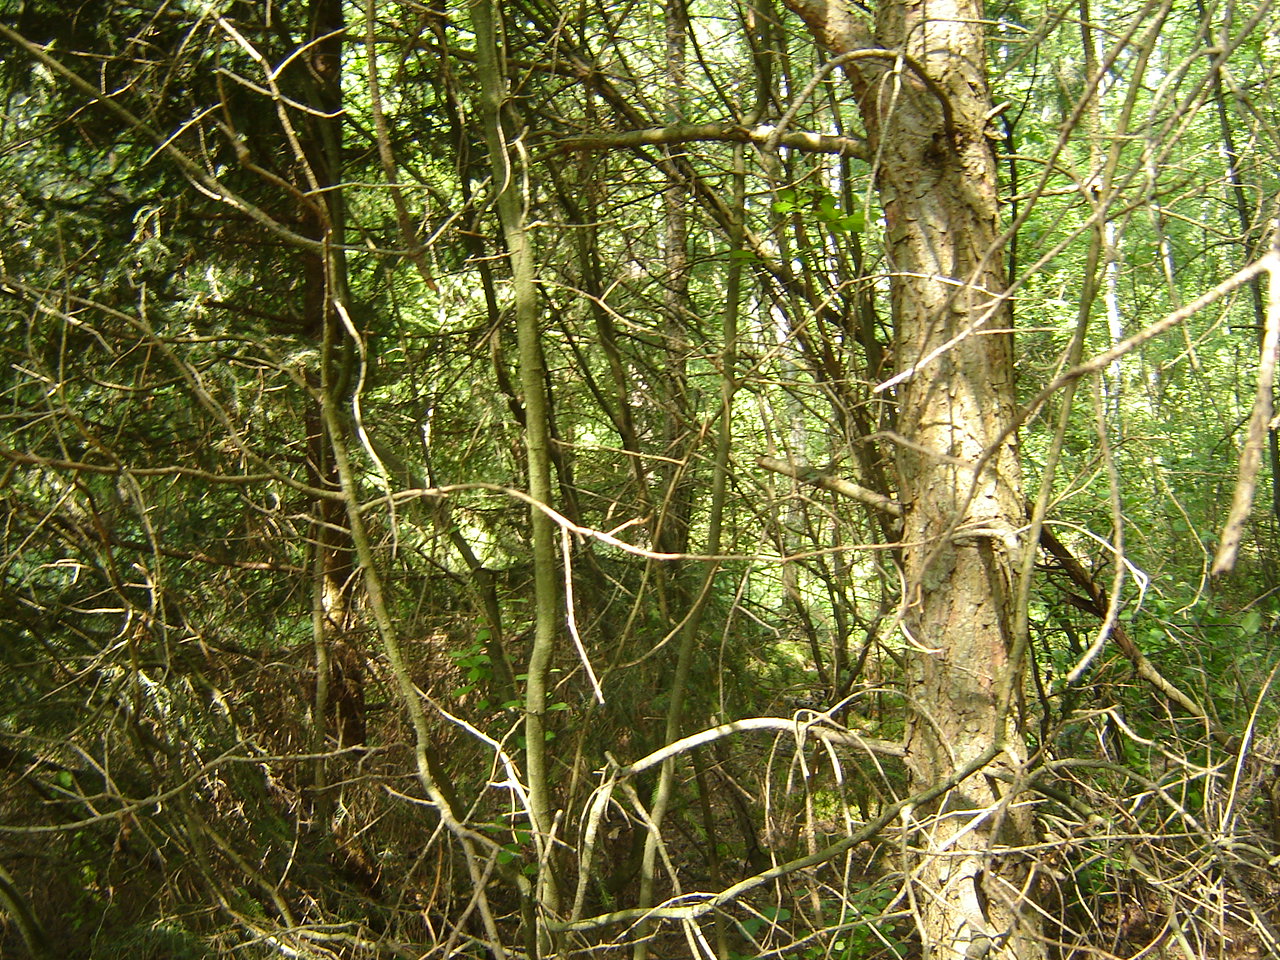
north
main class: Woodland
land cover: Other mixed woodland
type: hemiboreal forest and nemoral coniferous forest and mixed broadleaved-coniferous forest
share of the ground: > 75 %
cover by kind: broadleaved forest trees 50 %, coniferous forest trees 45 %, lichens and mosses 5 %
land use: Forestry
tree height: > 5 m
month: August
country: LT
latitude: 55.0538
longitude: 24.9040
